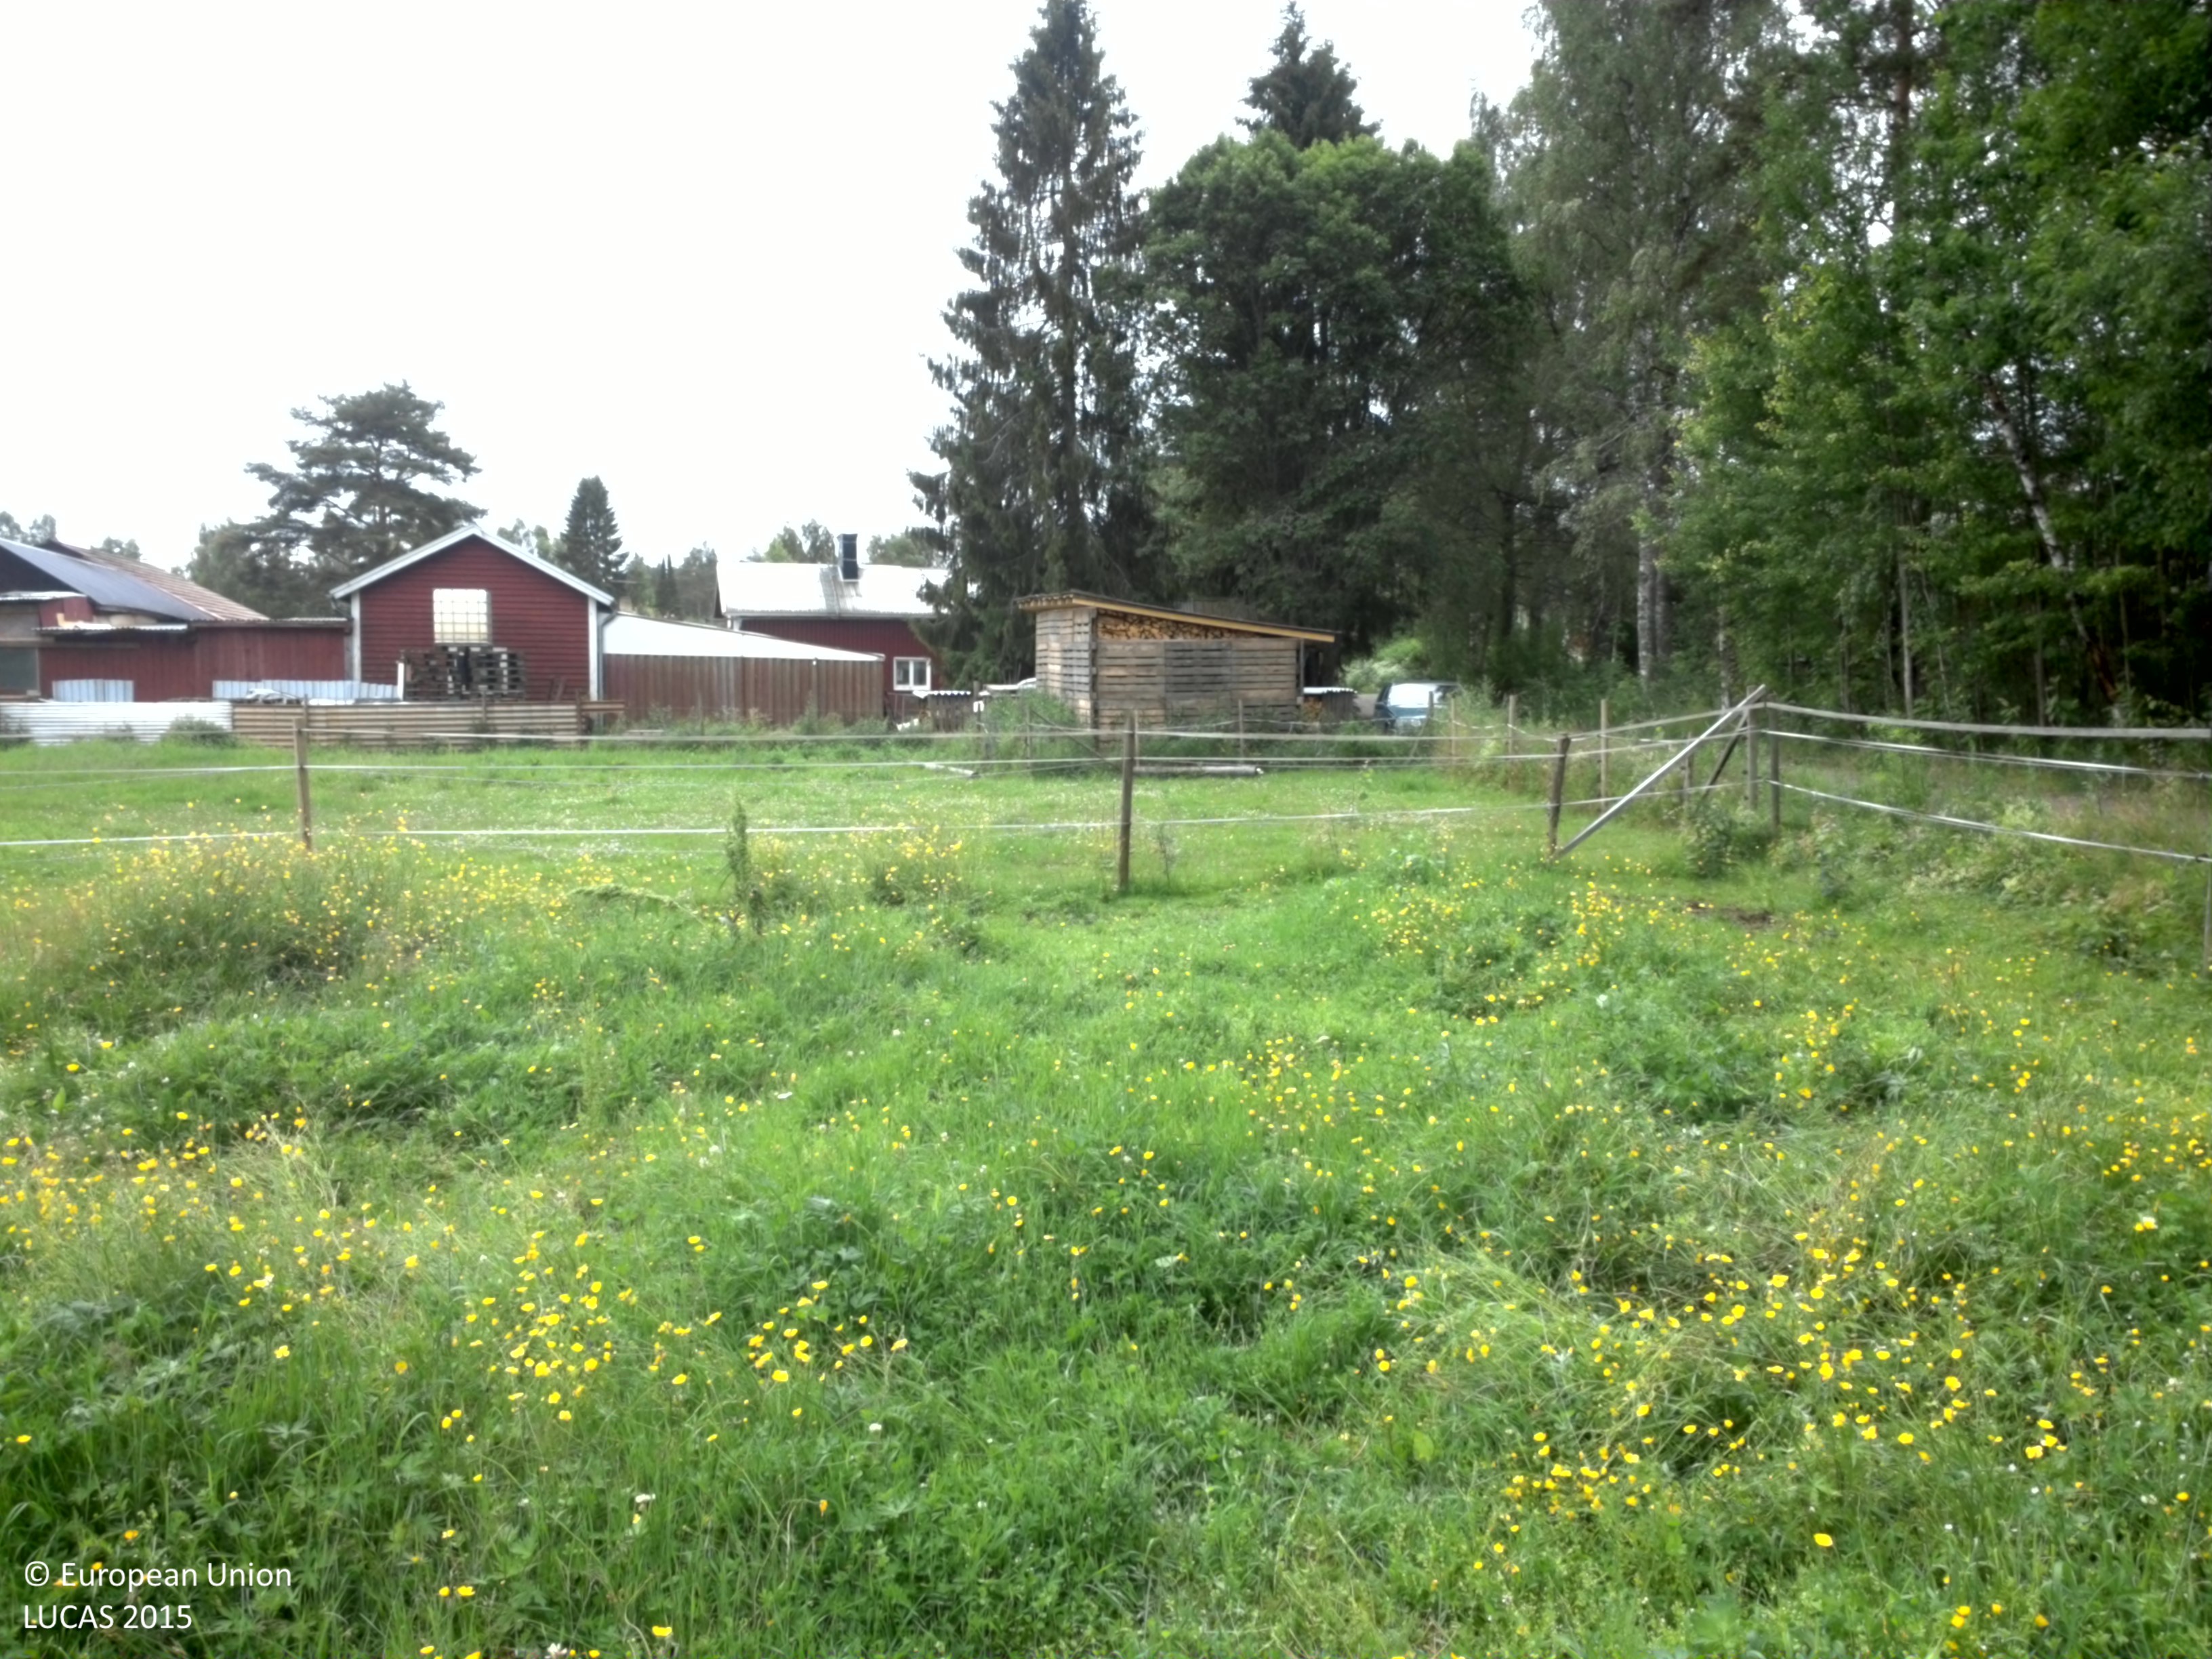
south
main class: Grassland
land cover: Grassland without tree/shrub cover
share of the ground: > 75 %
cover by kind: herbaceous plants 95 %, unconsolidated bare surface 5 %
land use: Agriculture (excluding fallow land and kitchen gardens)
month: July
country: SE
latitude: 59.7485
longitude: 14.4925
